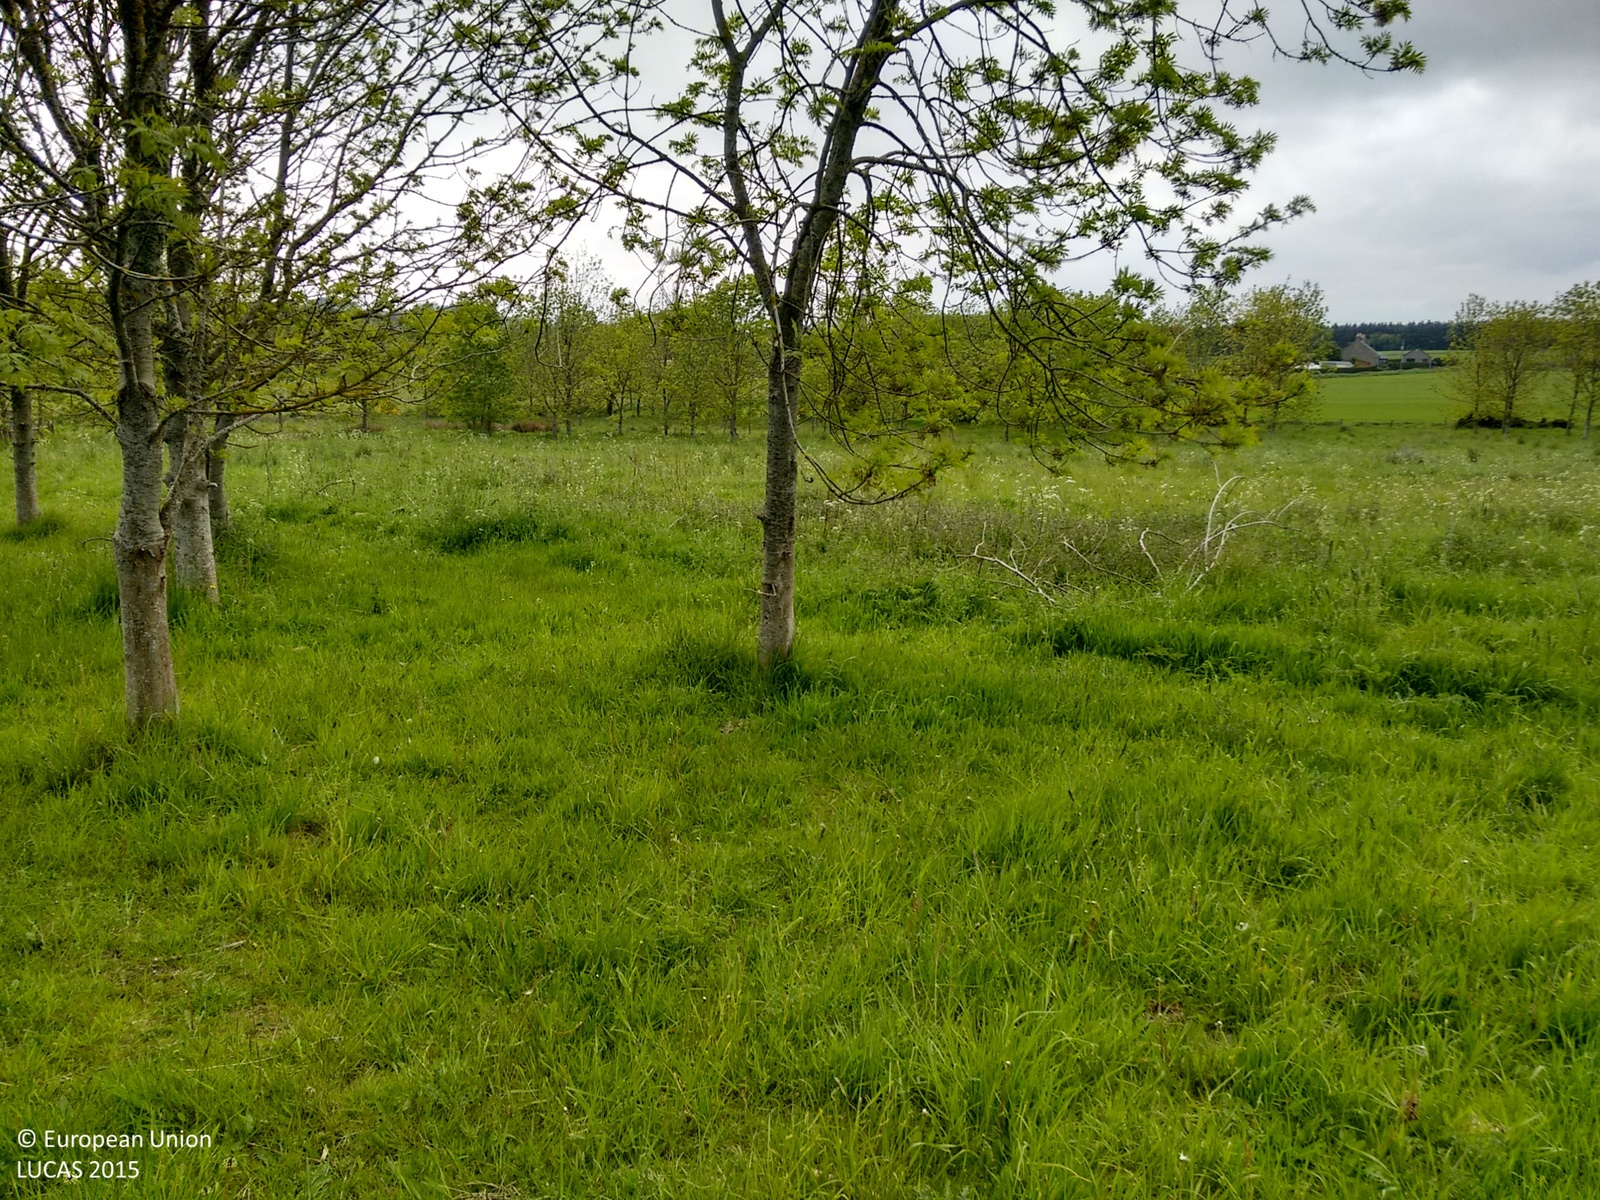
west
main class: Woodland
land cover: Broadleaved woodland
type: mesophytic deciduous forest
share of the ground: > 75 %
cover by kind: broadleaved forest trees 80 %, herbaceous plants 20 %
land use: Semi-natural and natural areas not in use
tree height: > 5 m
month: June
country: GB
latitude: 57.2779
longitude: -2.2071
